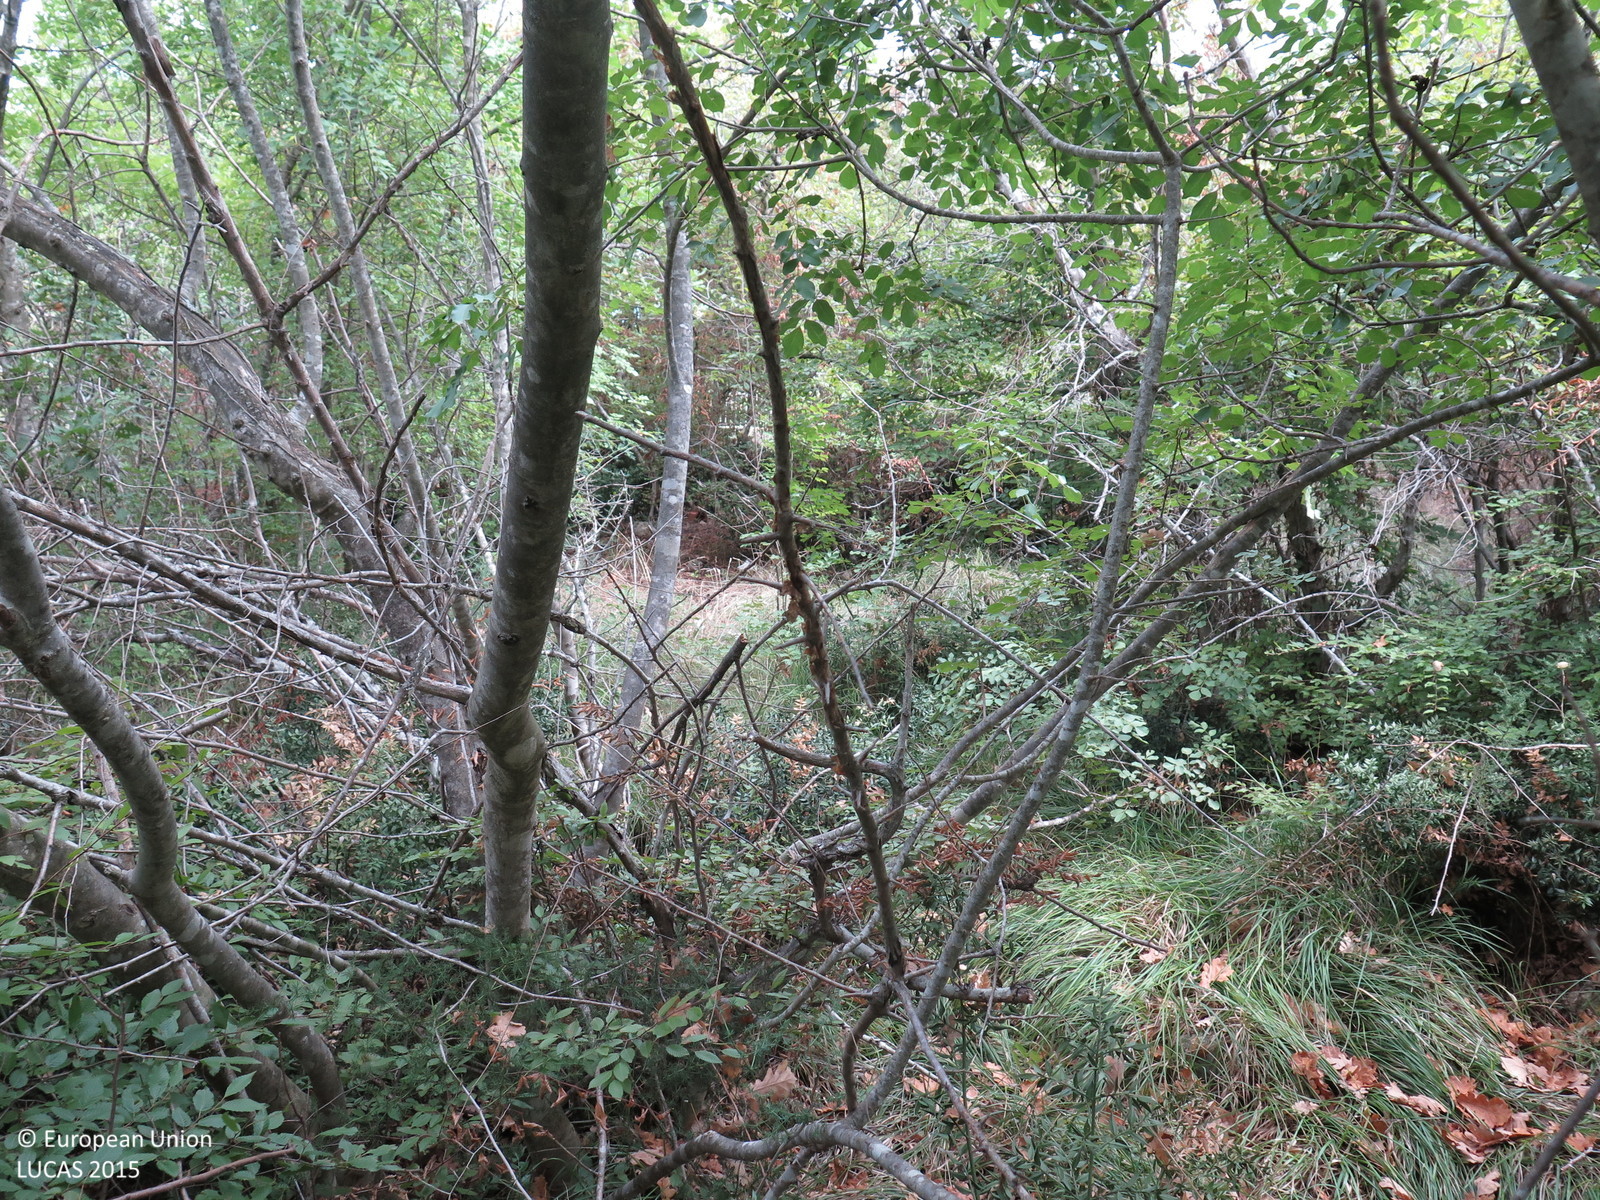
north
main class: Woodland
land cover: Broadleaved woodland
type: thermophilous deciduous forest
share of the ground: > 75 %
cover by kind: broadleaved forest trees 90 %, shrubs 5 %, herbaceous plants 5 %
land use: Semi-natural and natural areas not in use
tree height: > 5 m
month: August
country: HR
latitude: 45.1543
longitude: 14.5356
